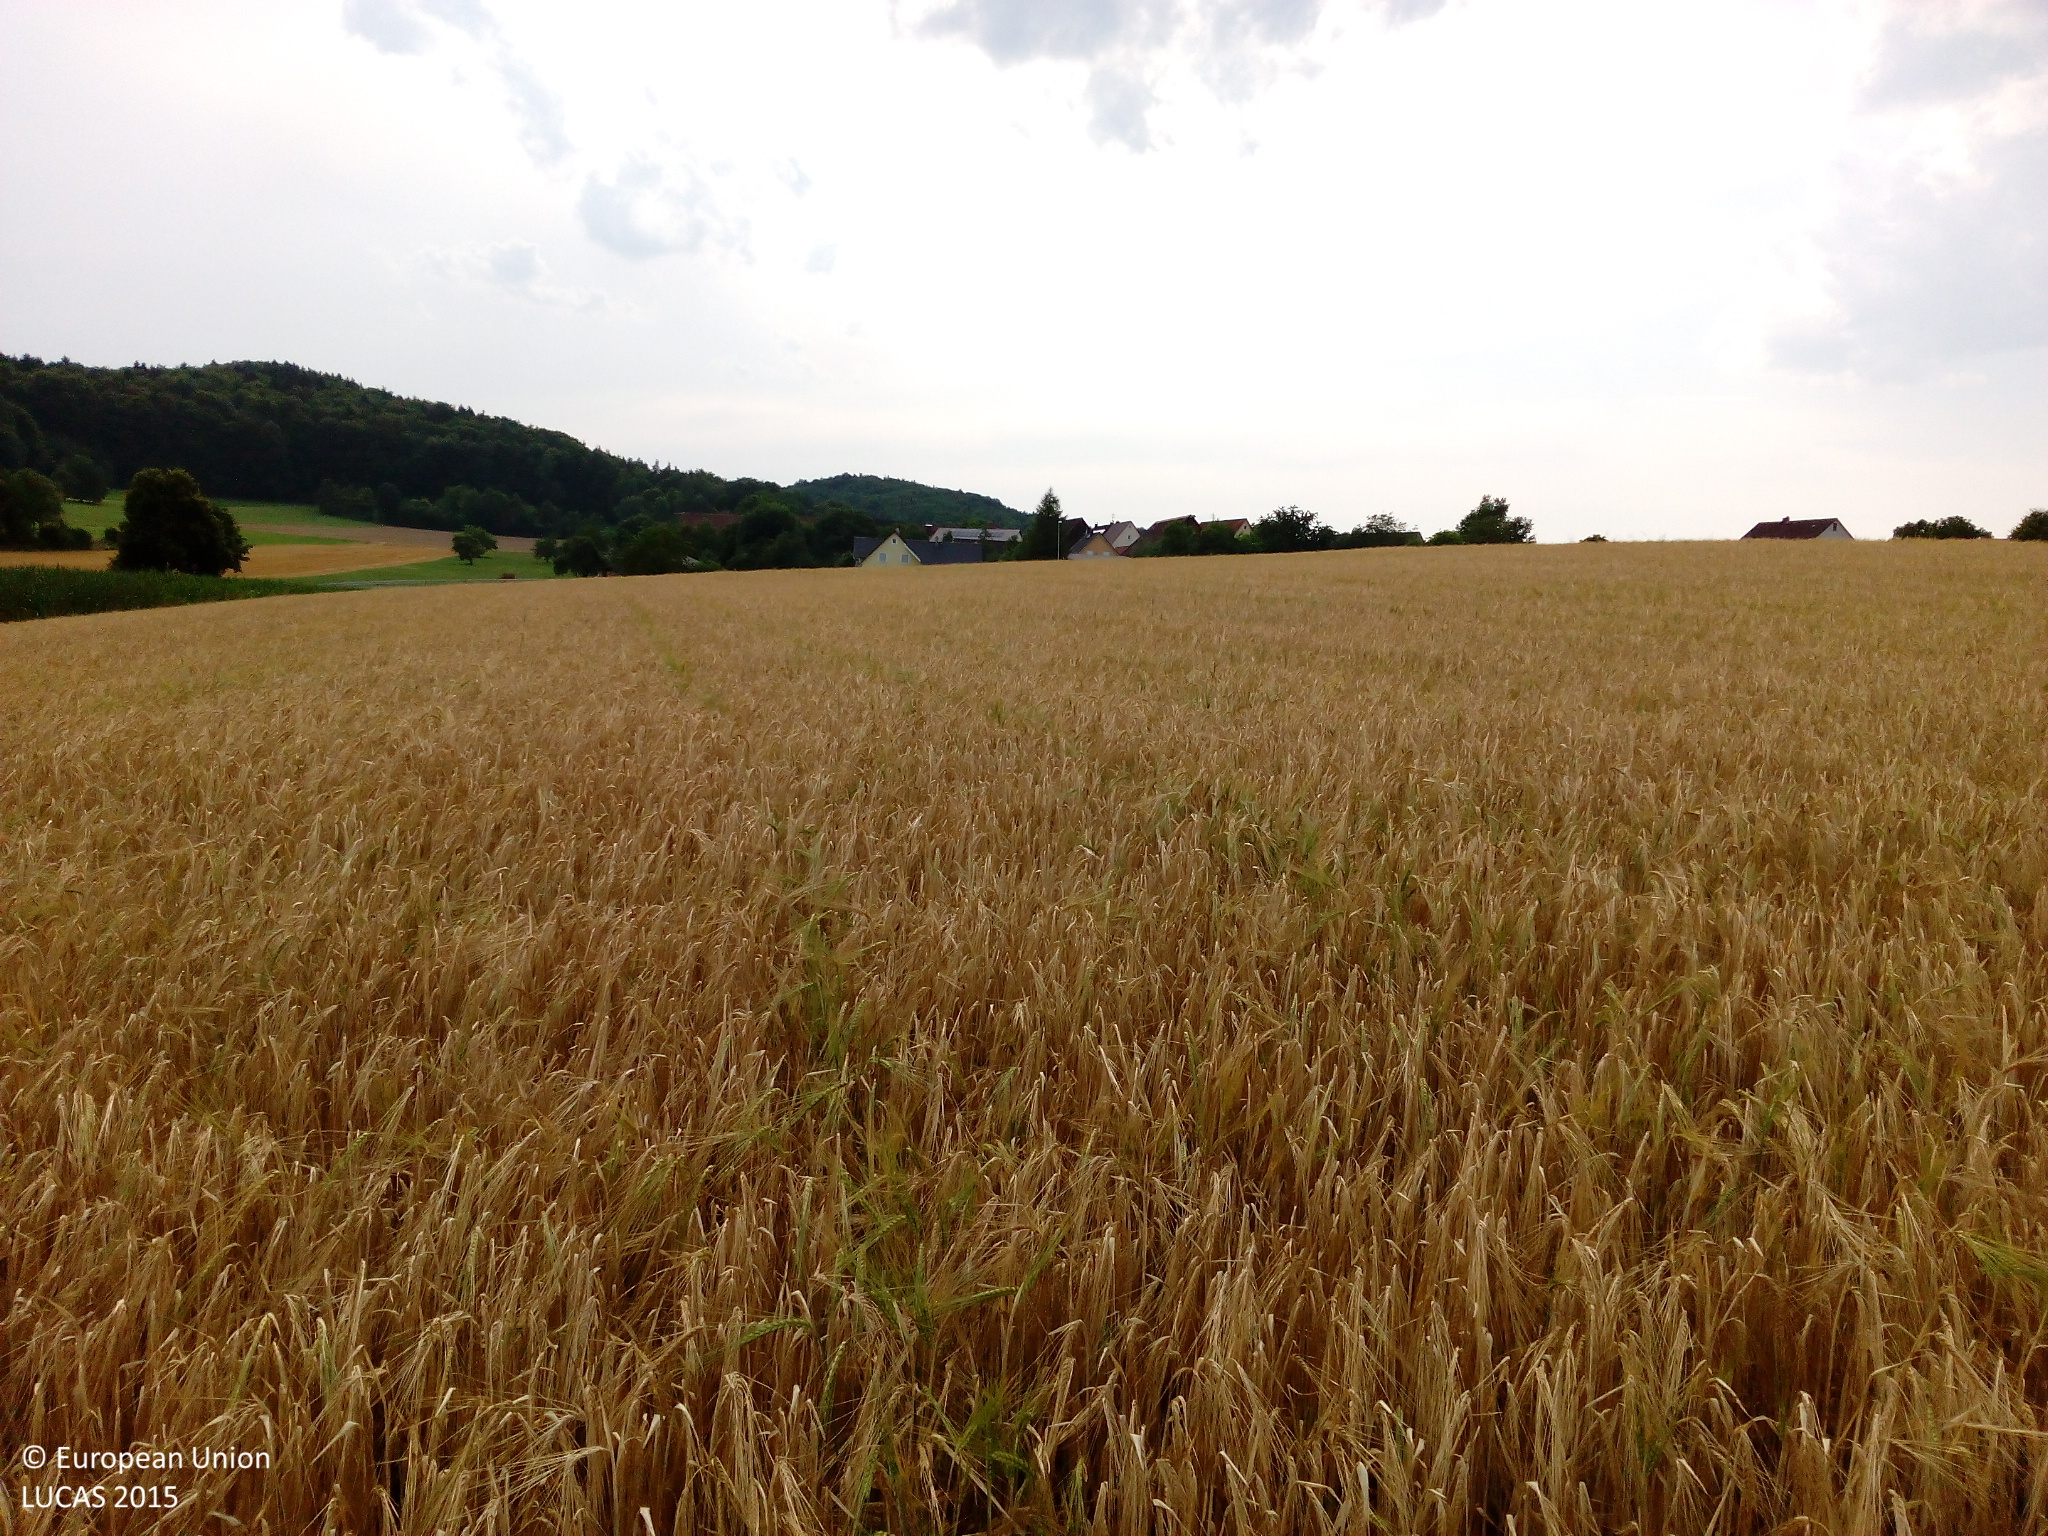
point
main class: Cropland
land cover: Barley
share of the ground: > 75 %
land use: Agriculture (excluding fallow land and kitchen gardens)
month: July
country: DE
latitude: 49.6350
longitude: 11.4811
